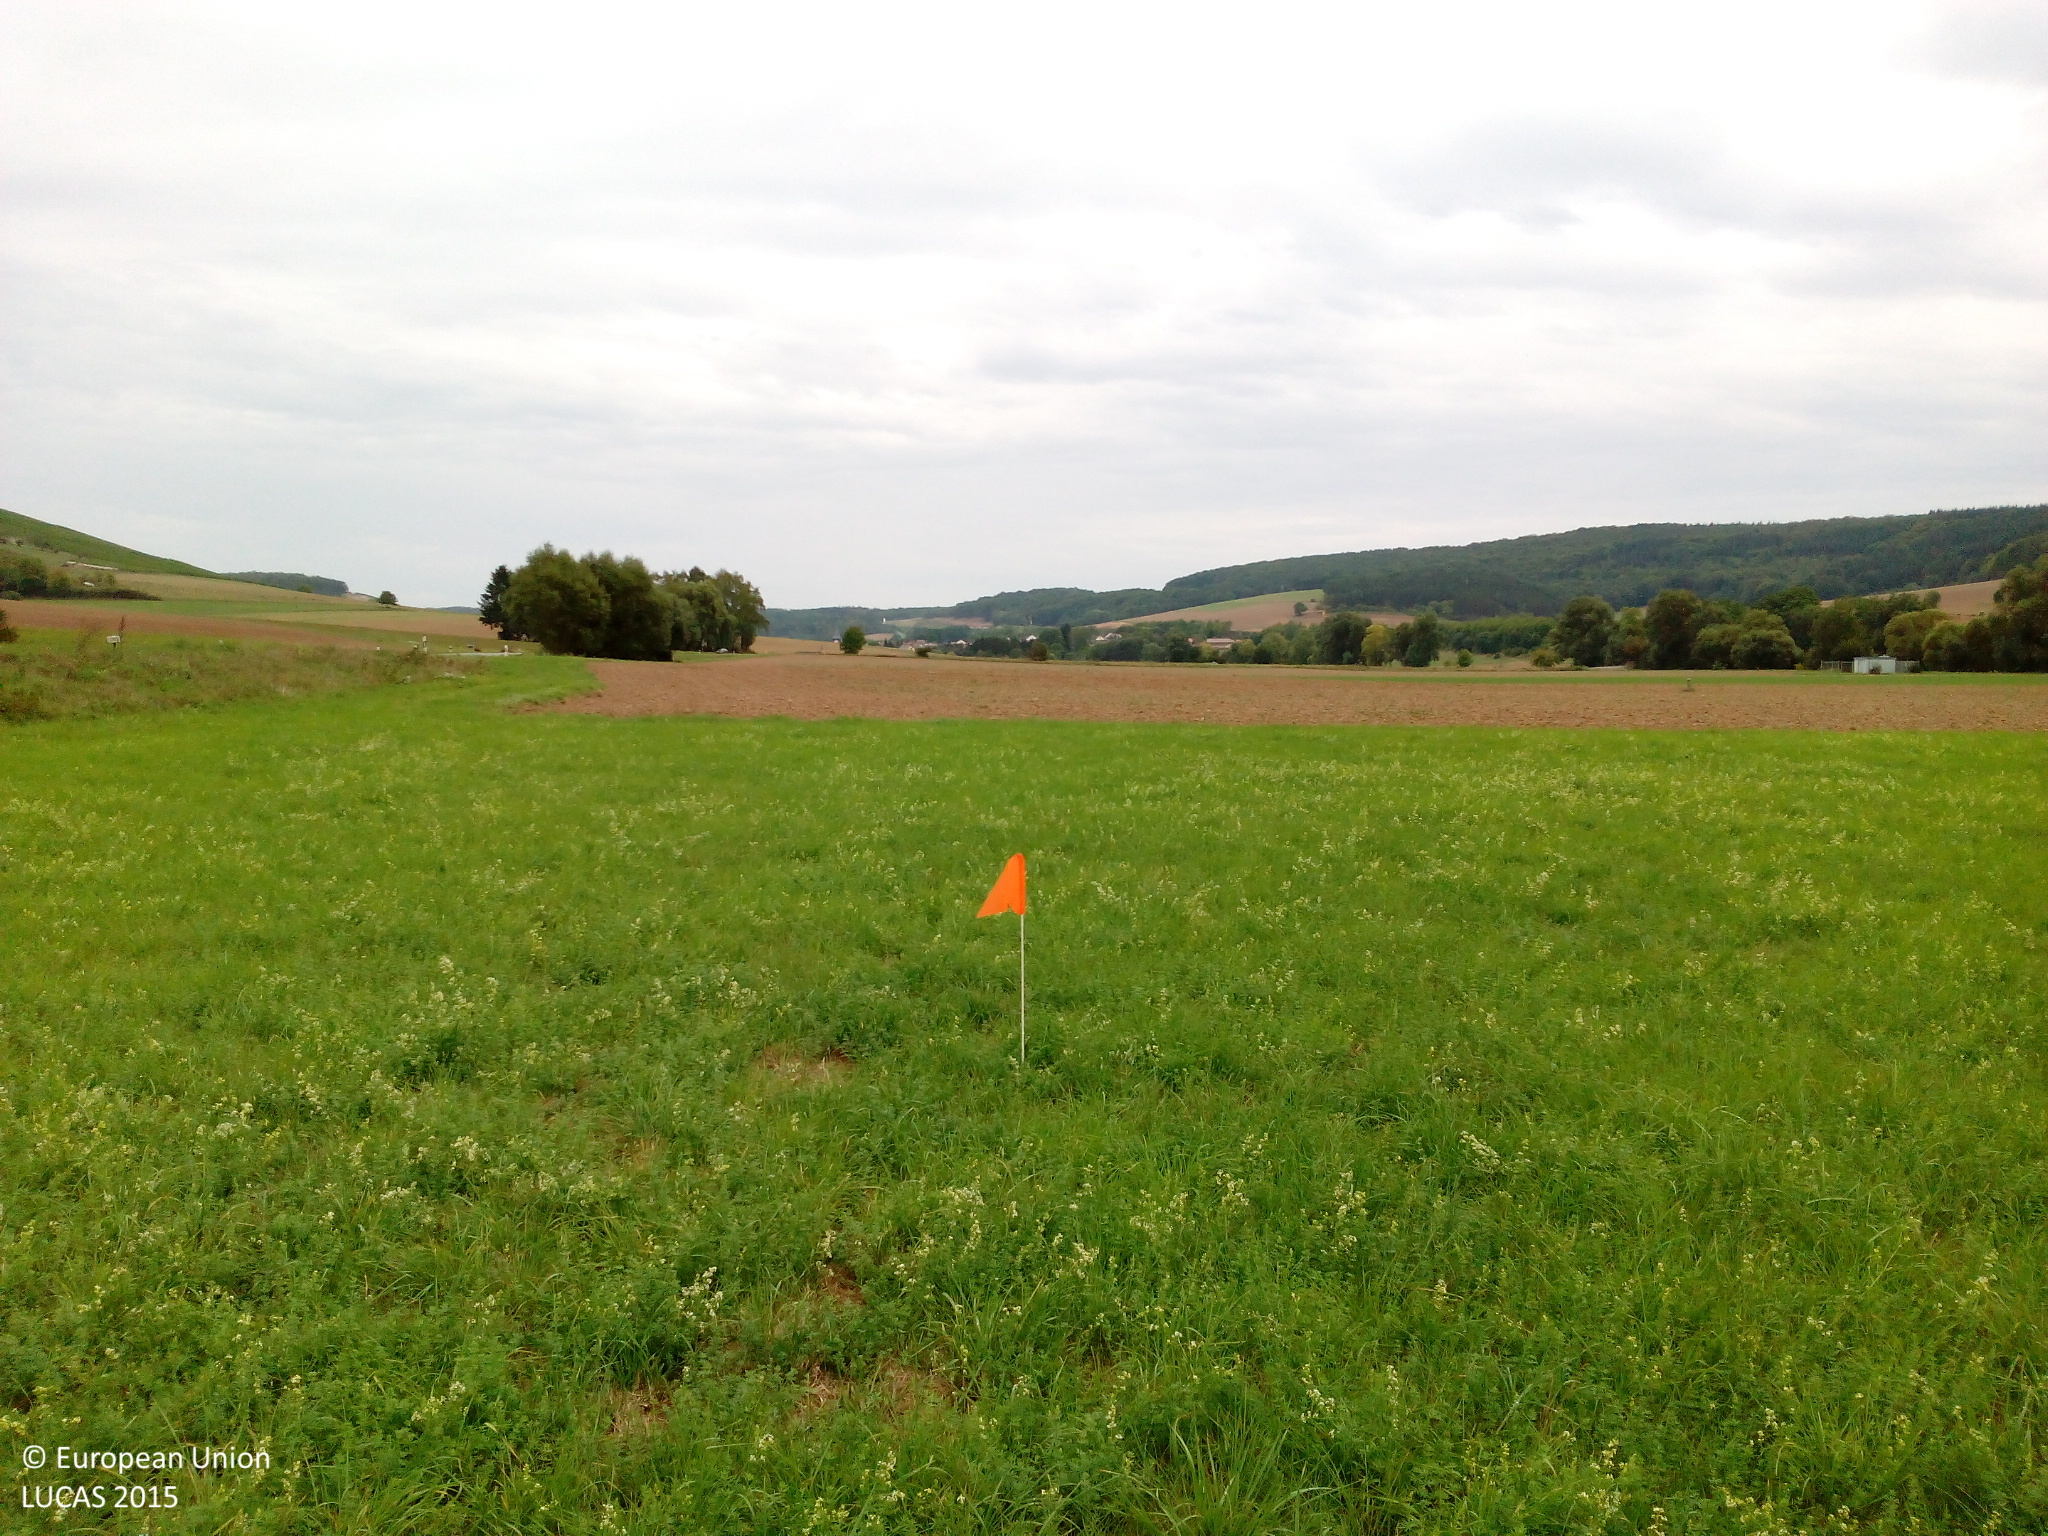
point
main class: Grassland
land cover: Grassland without tree/shrub cover
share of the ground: > 75 %
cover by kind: herbaceous plants 85 %, unconsolidated bare surface 10 %, lichens and mosses 5 %
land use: Agriculture (excluding fallow land and kitchen gardens)
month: September
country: DE
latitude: 49.7699
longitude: 9.5975
